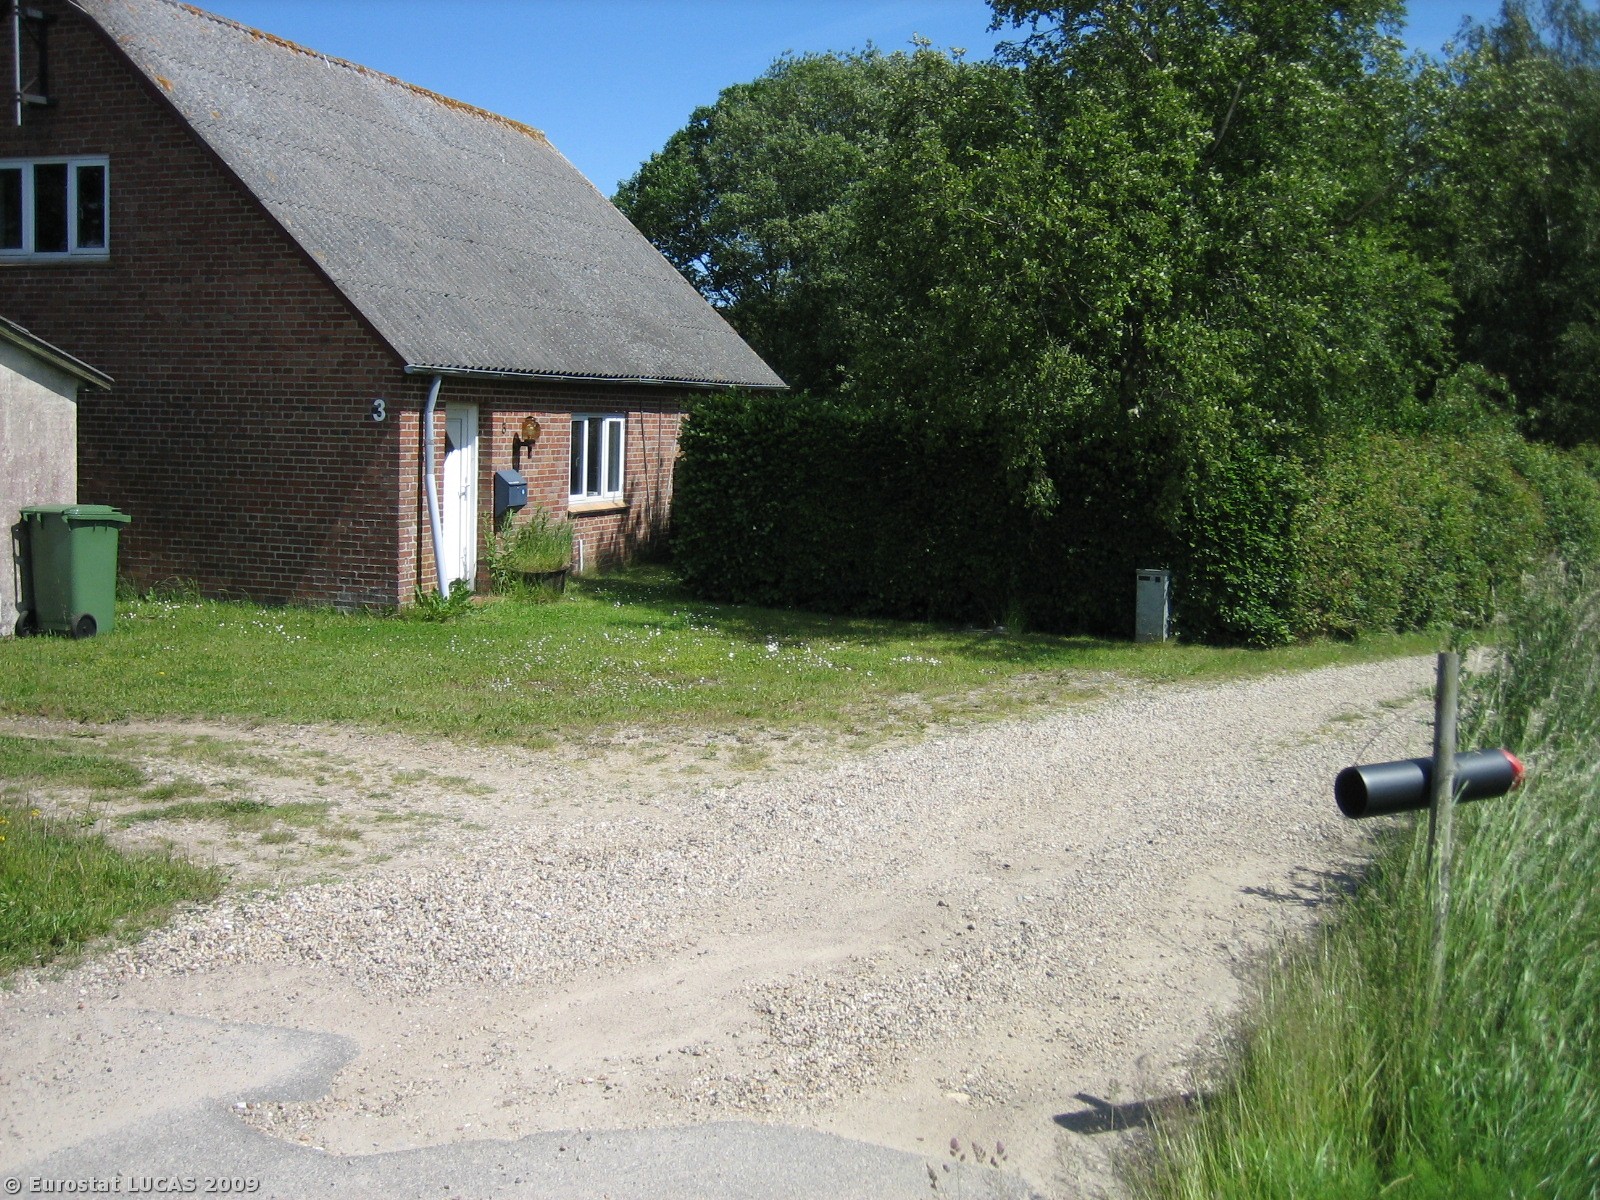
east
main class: Cropland
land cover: Common wheat
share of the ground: > 75 %
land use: Agriculture (excluding fallow land and kitchen gardens)
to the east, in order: Common wheat; Fences; Tracks; Broadleaved woodland; Grassland with sparse tree/shrub cover; Broadleaved woodland; Fences; Grassland without tree/shrub cover; Fences; Grassland without tree/shrub cover; Fences; Grassland without tree/shrub cover; Single bushes/trees; Grassland without tree/shrub cover
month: June
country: DK
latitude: 55.7024
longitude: 9.8887
